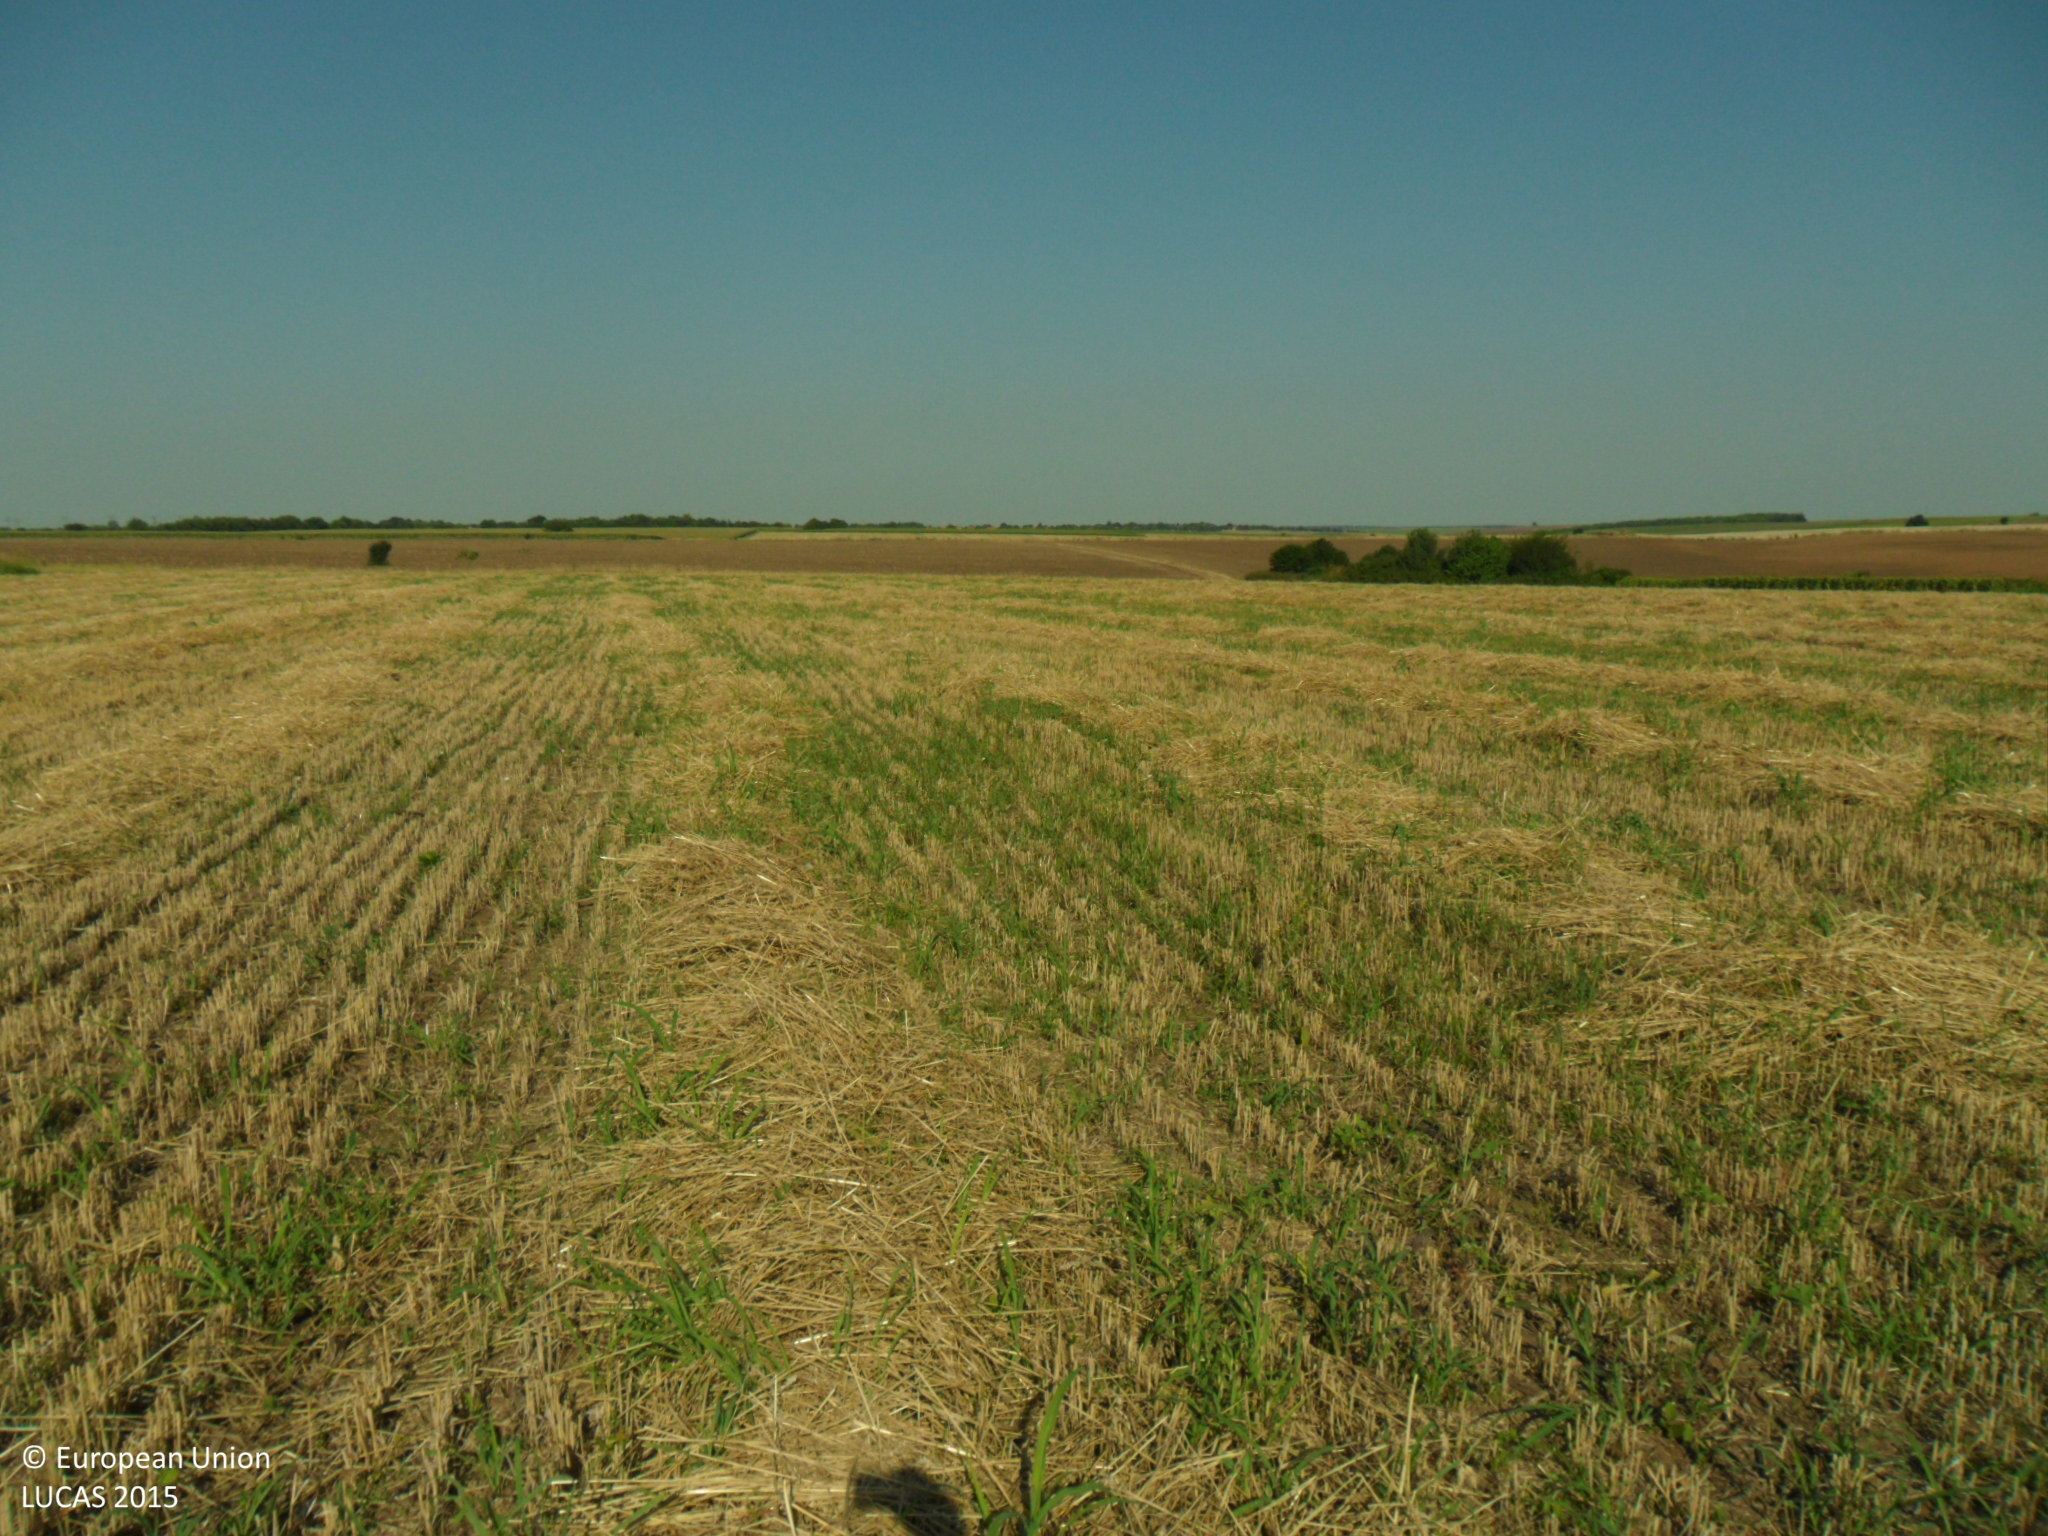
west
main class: Cropland
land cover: Common wheat
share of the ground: 10 - 25 %
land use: Agriculture (excluding fallow land and kitchen gardens)
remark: Harvested field
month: July
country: BG
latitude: 43.8182
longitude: 26.3291
